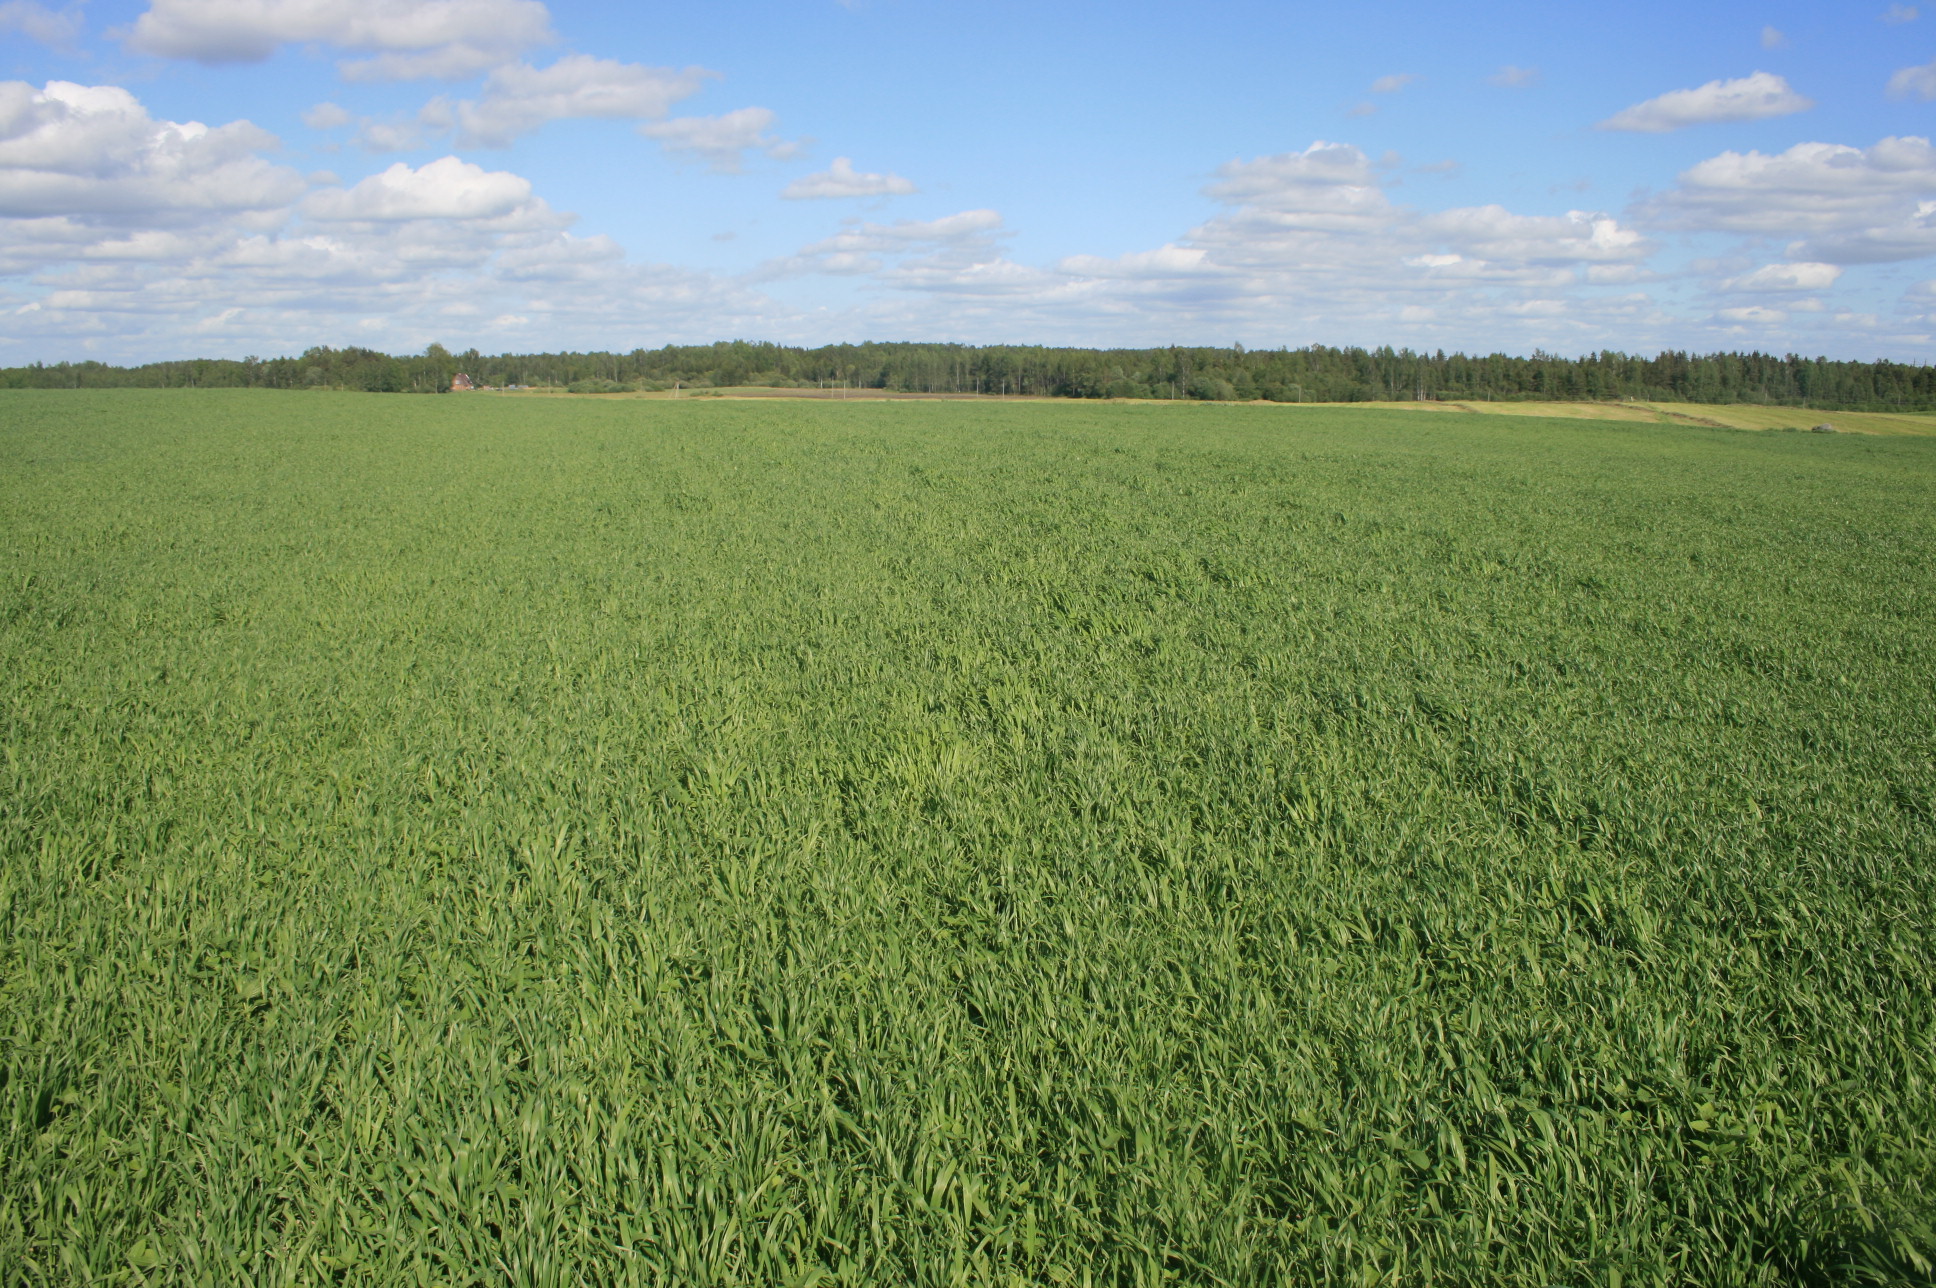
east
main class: Cropland
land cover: Common wheat
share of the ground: > 75 %
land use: Agriculture (excluding fallow land and kitchen gardens)
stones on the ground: < 10 %
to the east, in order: Common wheat; Grassland without tree/shrub cover
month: June
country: LT
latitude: 56.0242
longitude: 22.3632
